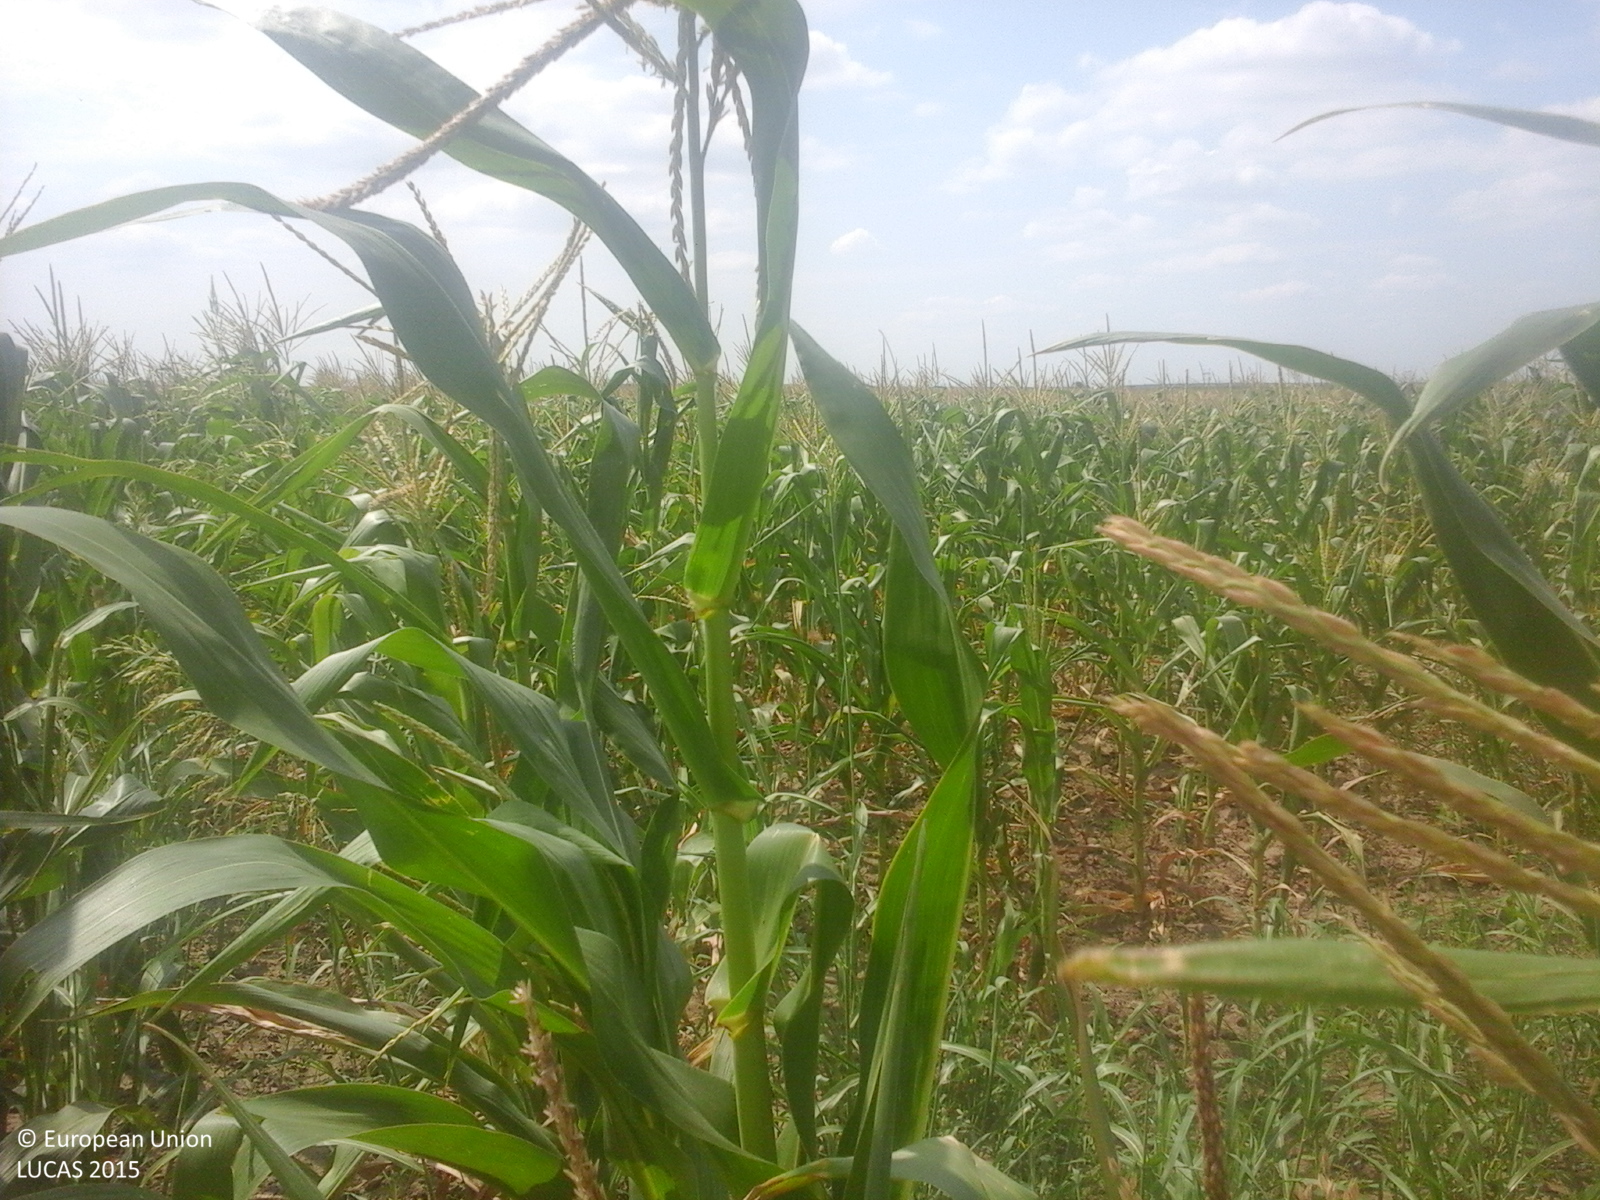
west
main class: Cropland
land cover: Maize
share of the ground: > 75 %
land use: Agriculture (excluding fallow land and kitchen gardens)
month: August
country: RO
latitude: 44.6900
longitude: 28.2495
